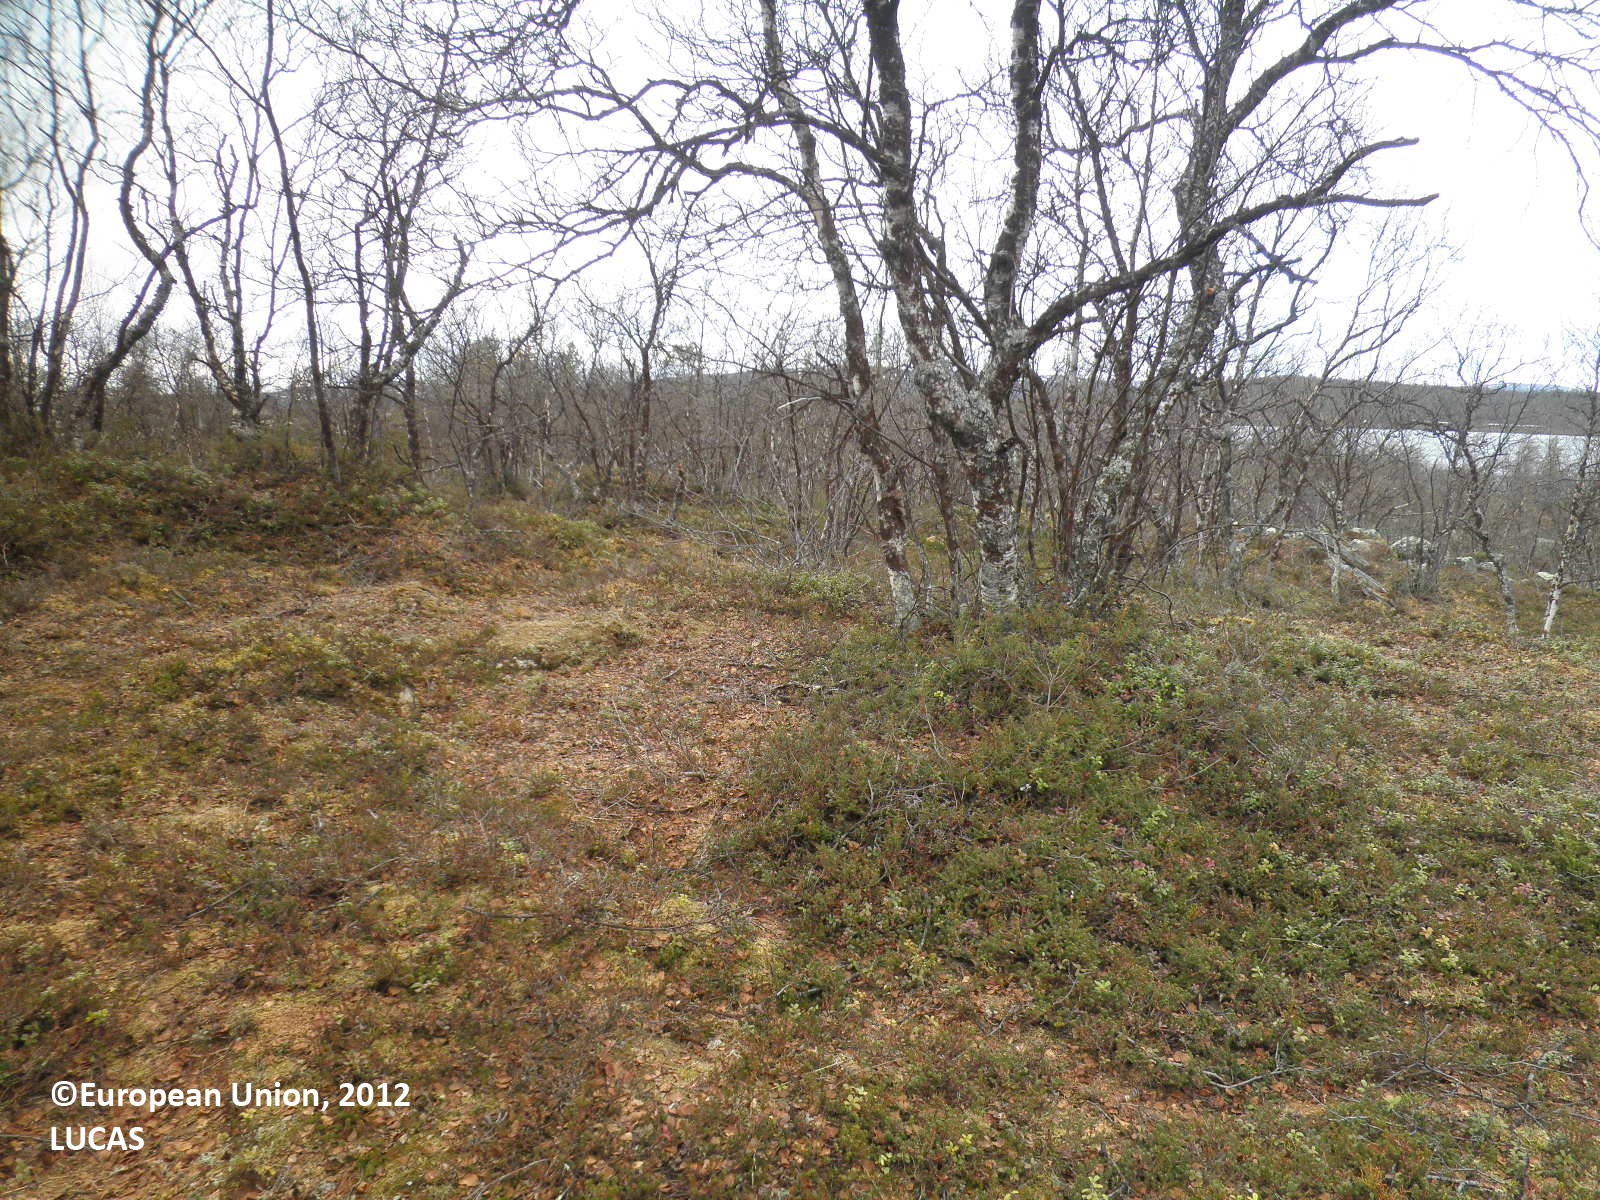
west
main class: Woodland
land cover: Broadleaved woodland
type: boreal forest
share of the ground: 50 - 75 %
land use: Forestry
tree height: > 5 m
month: May
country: FI
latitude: 69.1819
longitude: 26.9192
